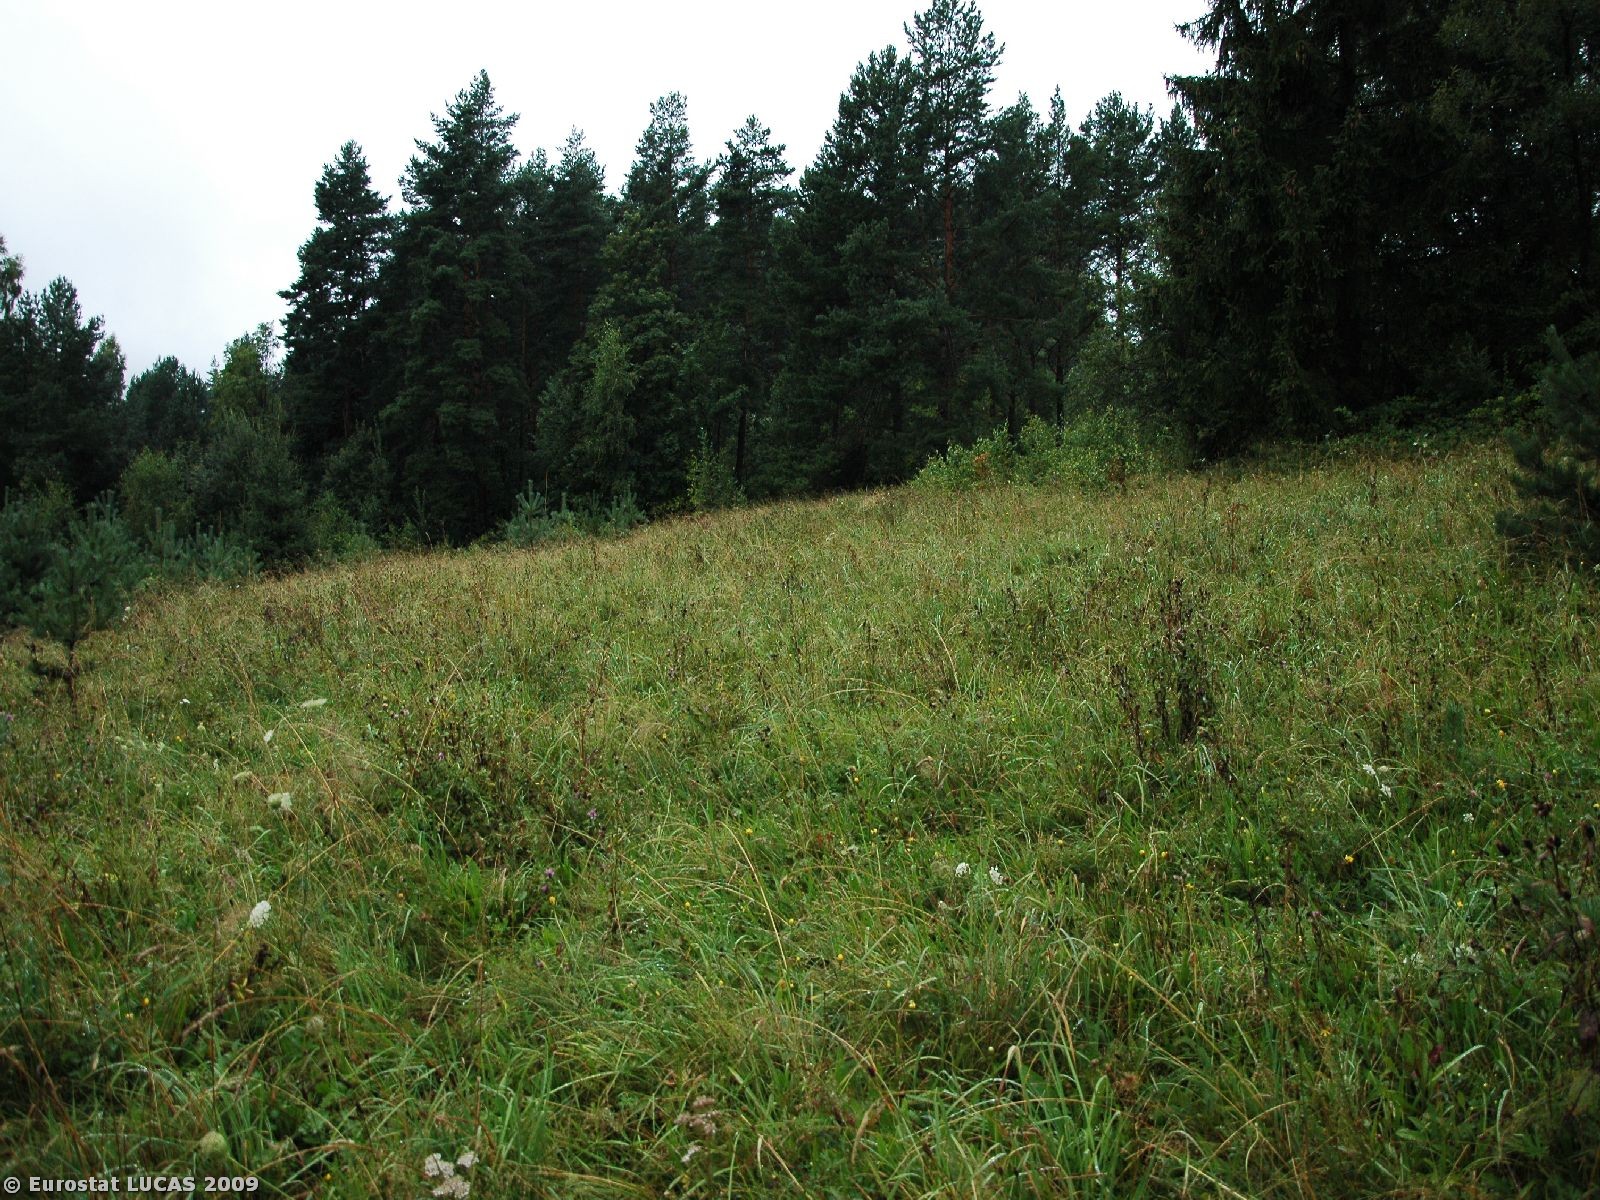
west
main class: Grassland
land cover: Grassland with sparse tree/shrub cover
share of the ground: > 75 %
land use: Unused
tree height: > 5 m
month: August
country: PL
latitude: 49.5523
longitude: 19.0491
